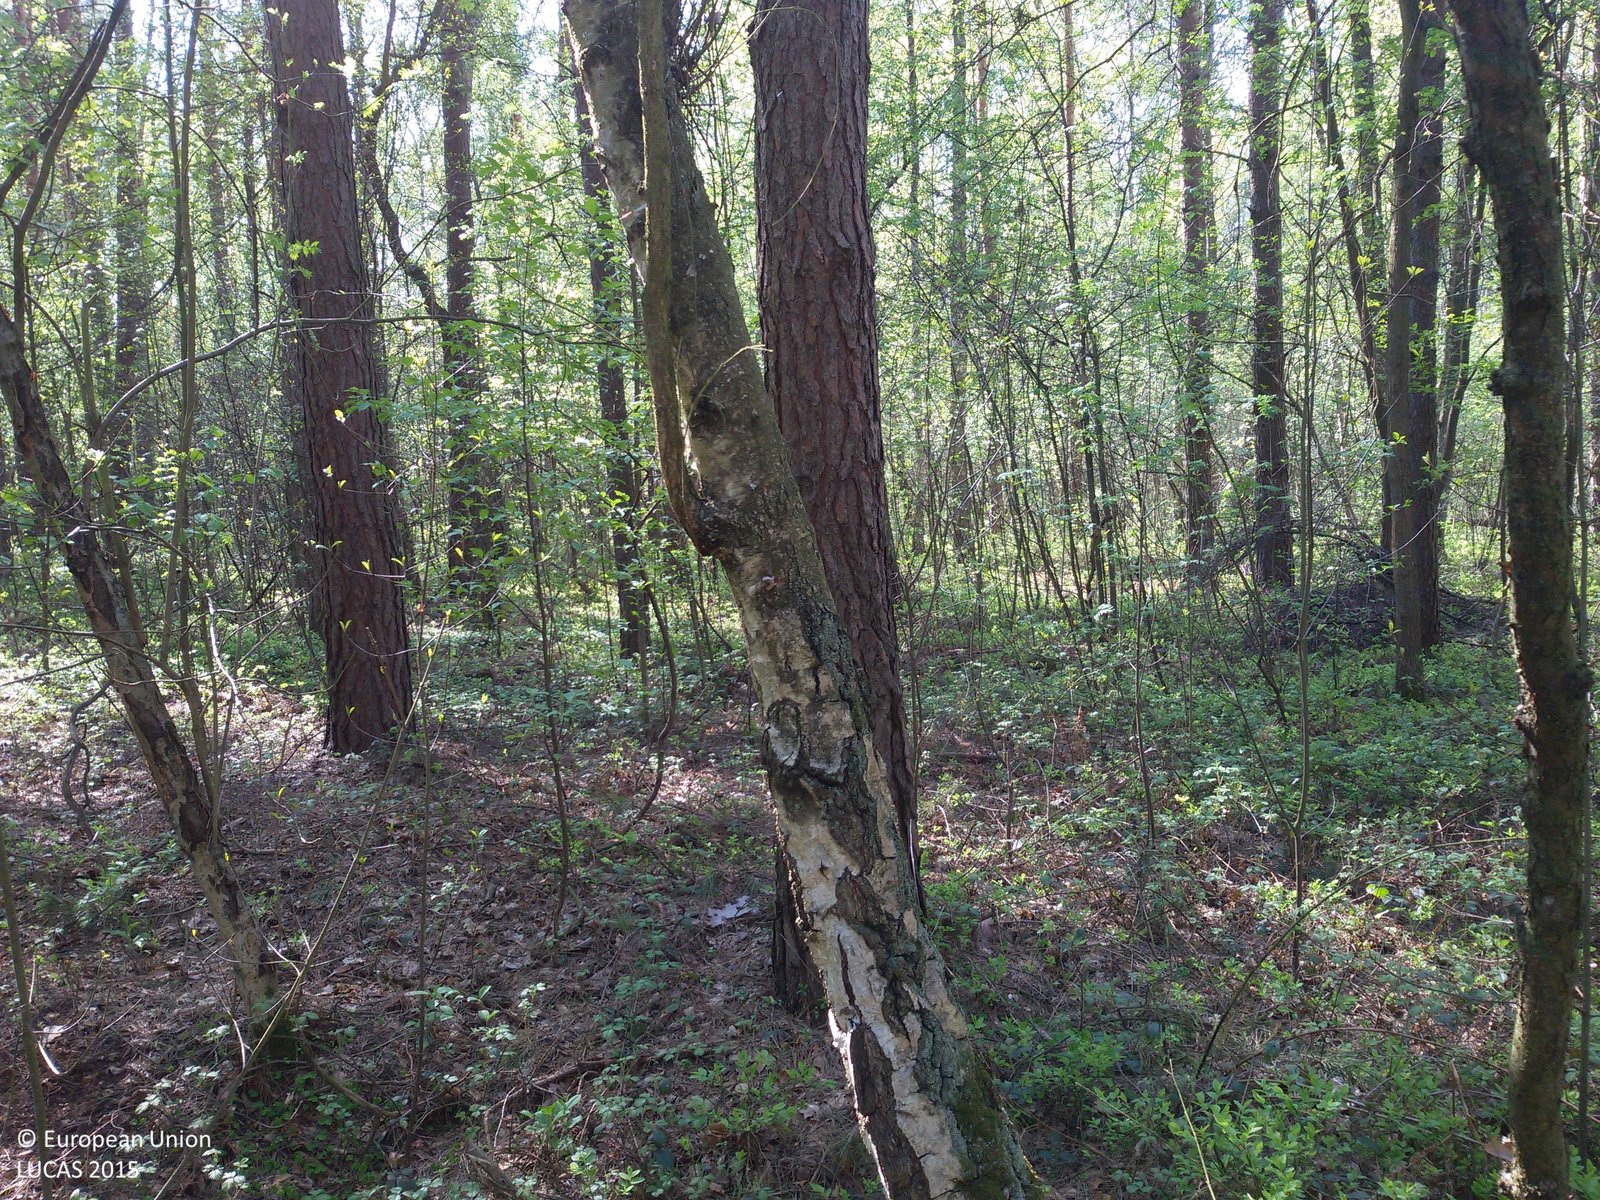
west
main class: Woodland
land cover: Pine dominated mixed woodland
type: hemiboreal forest and nemoral coniferous forest and mixed broadleaved-coniferous forest
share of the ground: > 75 %
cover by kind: coniferous forest trees 65 %, broadleaved forest trees 25 %, shrubs 5 %, herbaceous plants 5 %
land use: Forestry
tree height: > 5 m
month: May
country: PL
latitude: 51.8761
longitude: 21.0703
